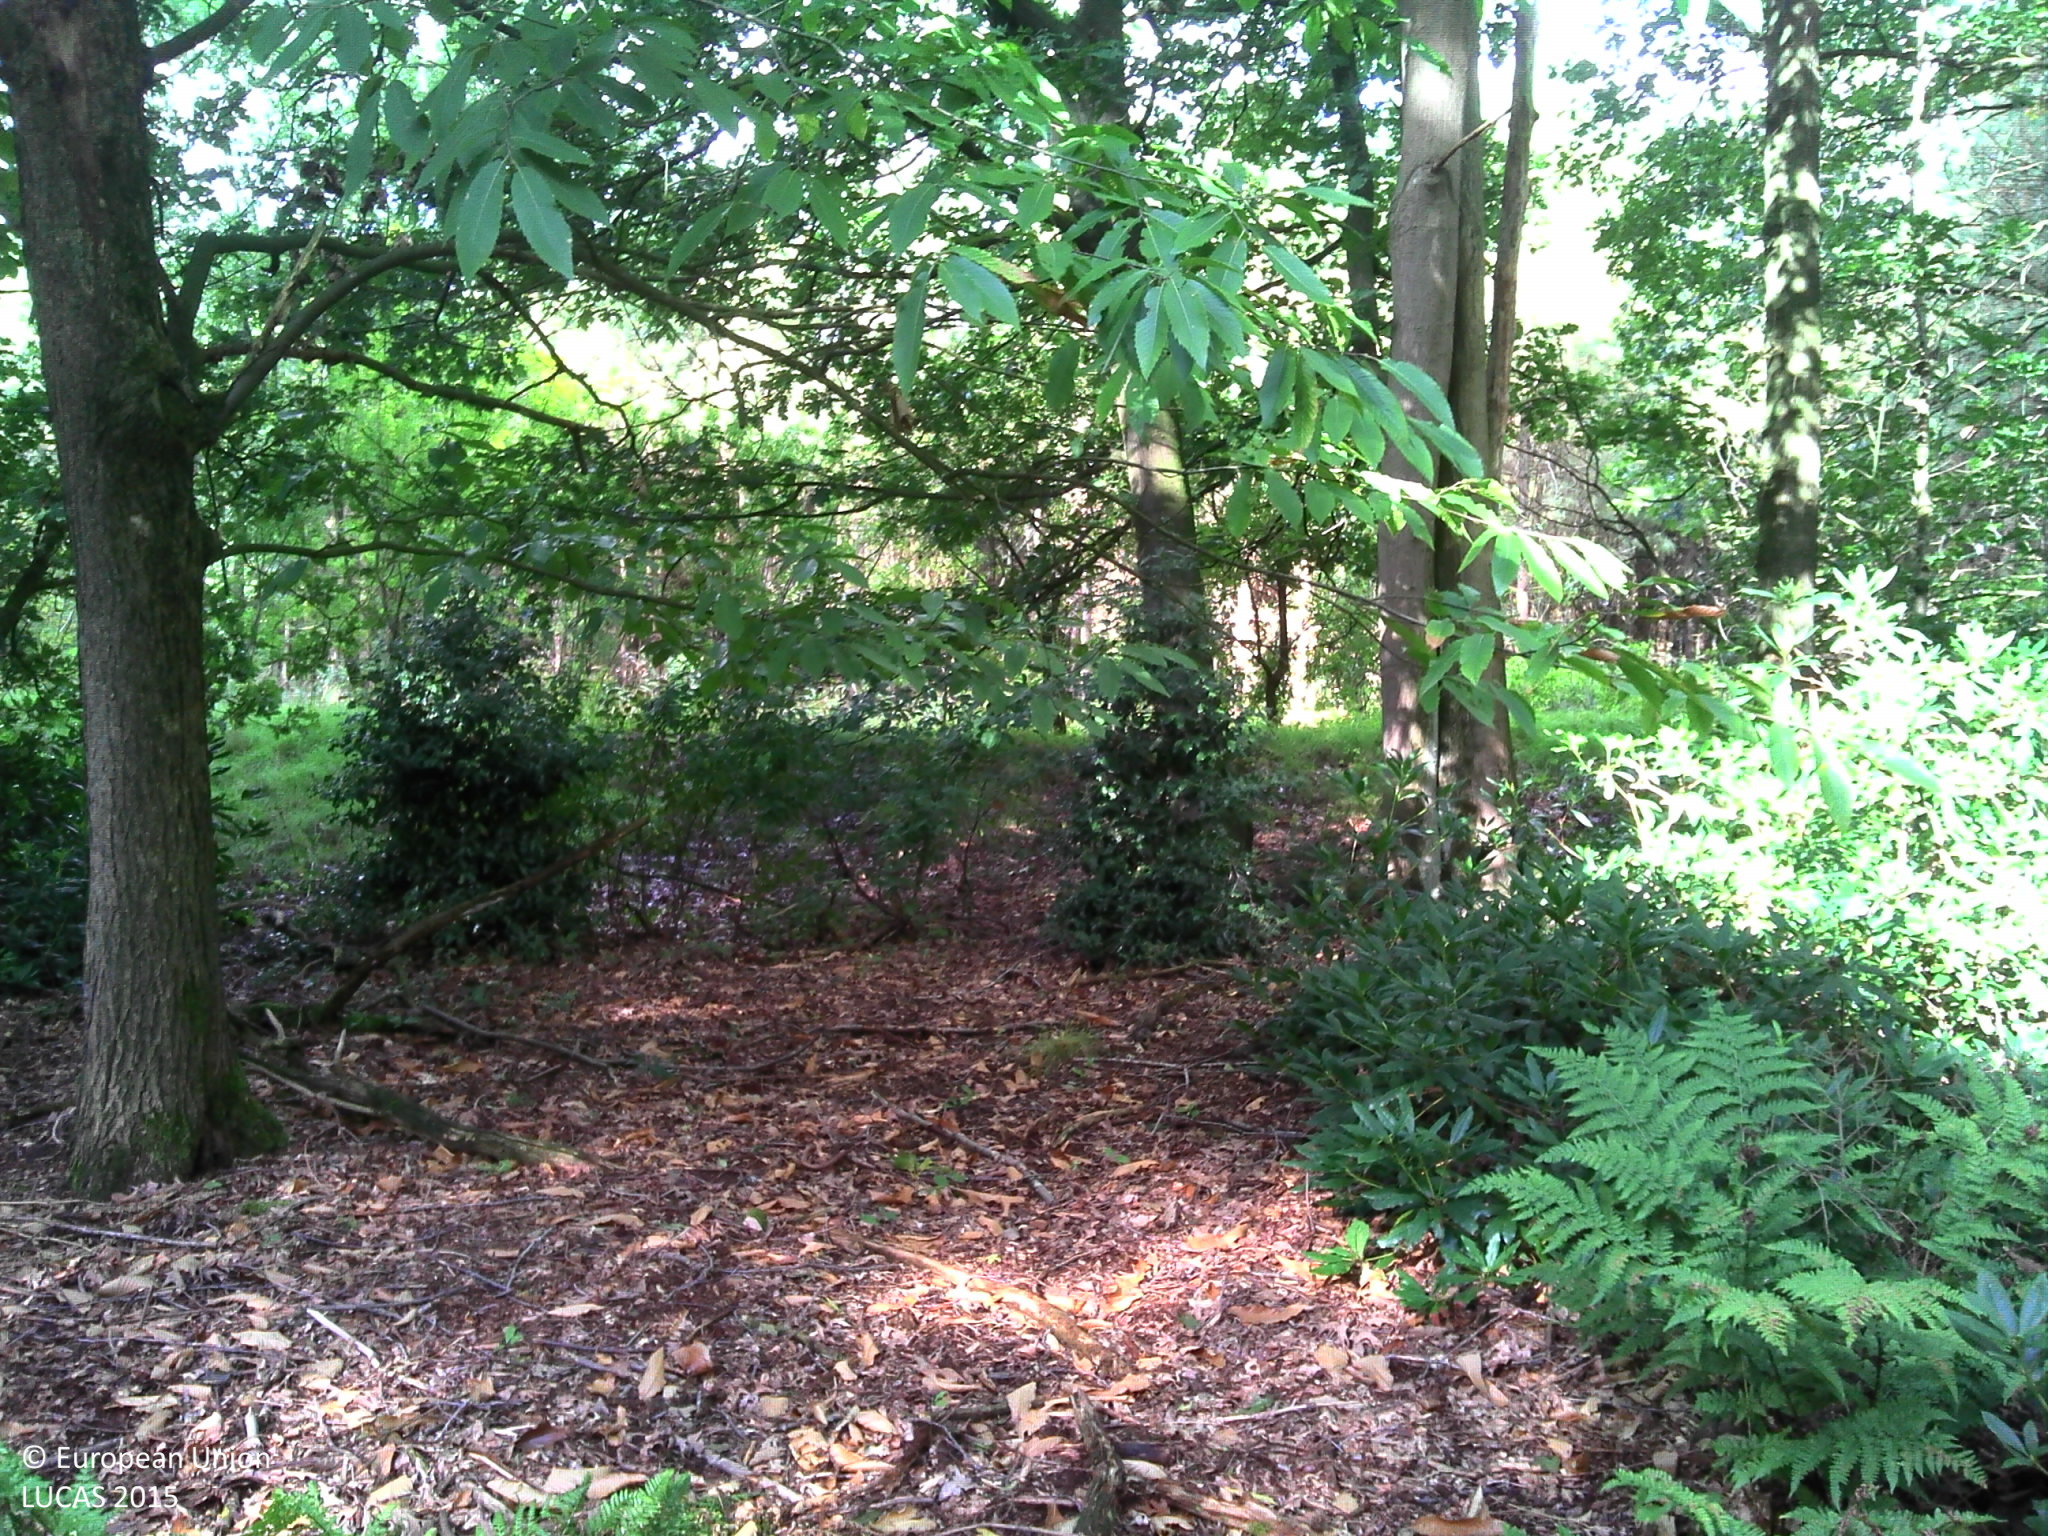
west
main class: Woodland
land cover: Broadleaved woodland
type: acidophilous oak and oak-birch forest
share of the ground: > 75 %
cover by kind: broadleaved forest trees 70 %, shrubs 20 %, herbaceous plants 10 %
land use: Forestry
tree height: > 5 m
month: September
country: BE
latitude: 51.4041
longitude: 4.5189
